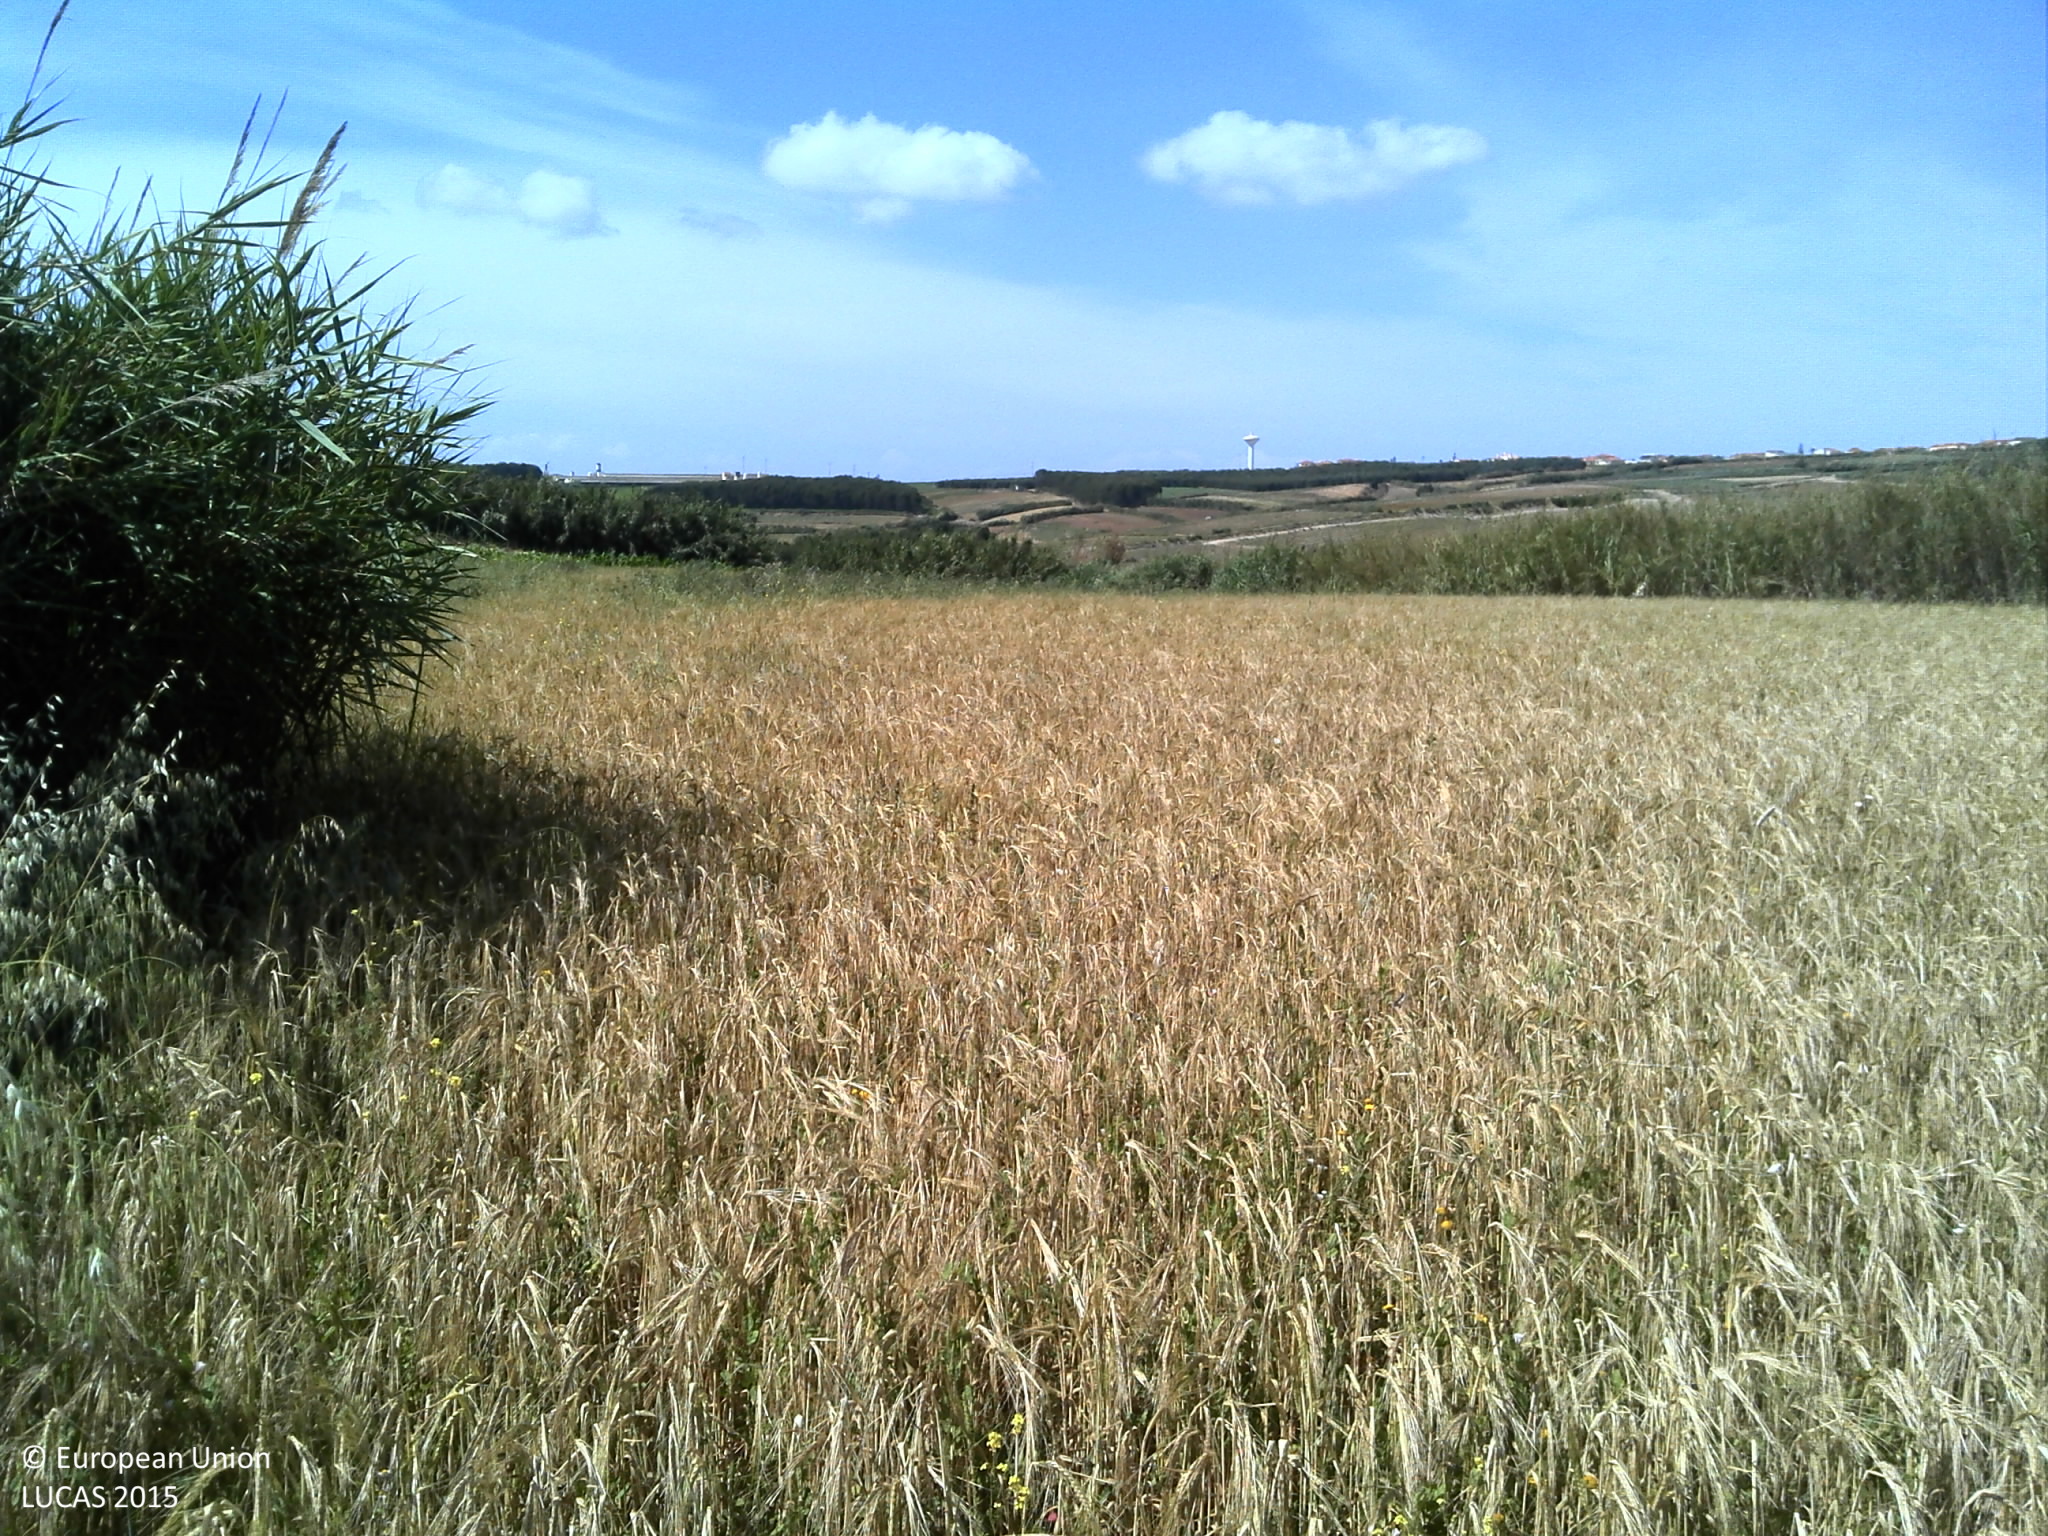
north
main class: Cropland
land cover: Common wheat
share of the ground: > 75 %
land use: Agriculture (excluding fallow land and kitchen gardens)
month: June
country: PT
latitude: 39.2889
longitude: -9.3267
